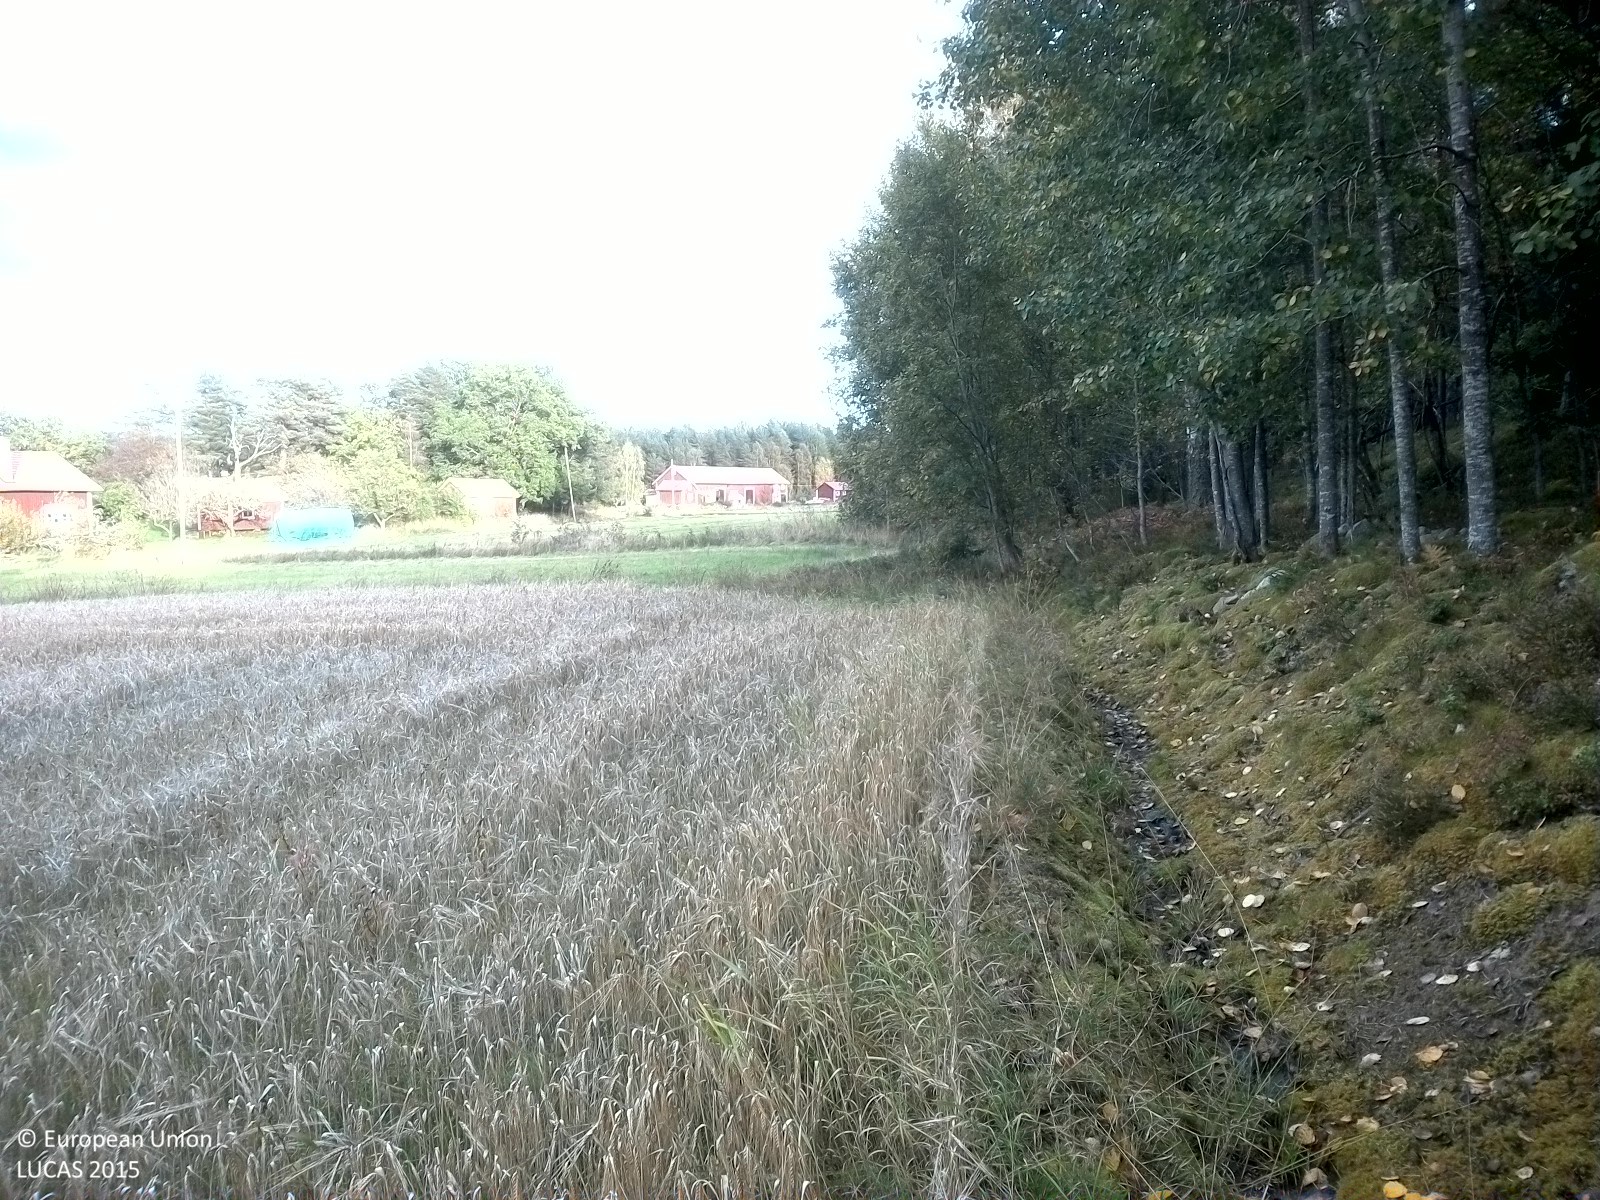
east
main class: Cropland
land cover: Barley
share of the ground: > 75 %
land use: Agriculture (excluding fallow land and kitchen gardens)
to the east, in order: Ditches and canals; Grassland without tree/shrub cover; Ditches and canals; Grassland without tree/shrub cover; Spontaneously vegetated surfaces
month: September
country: SE
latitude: 58.6507
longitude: 17.0110
